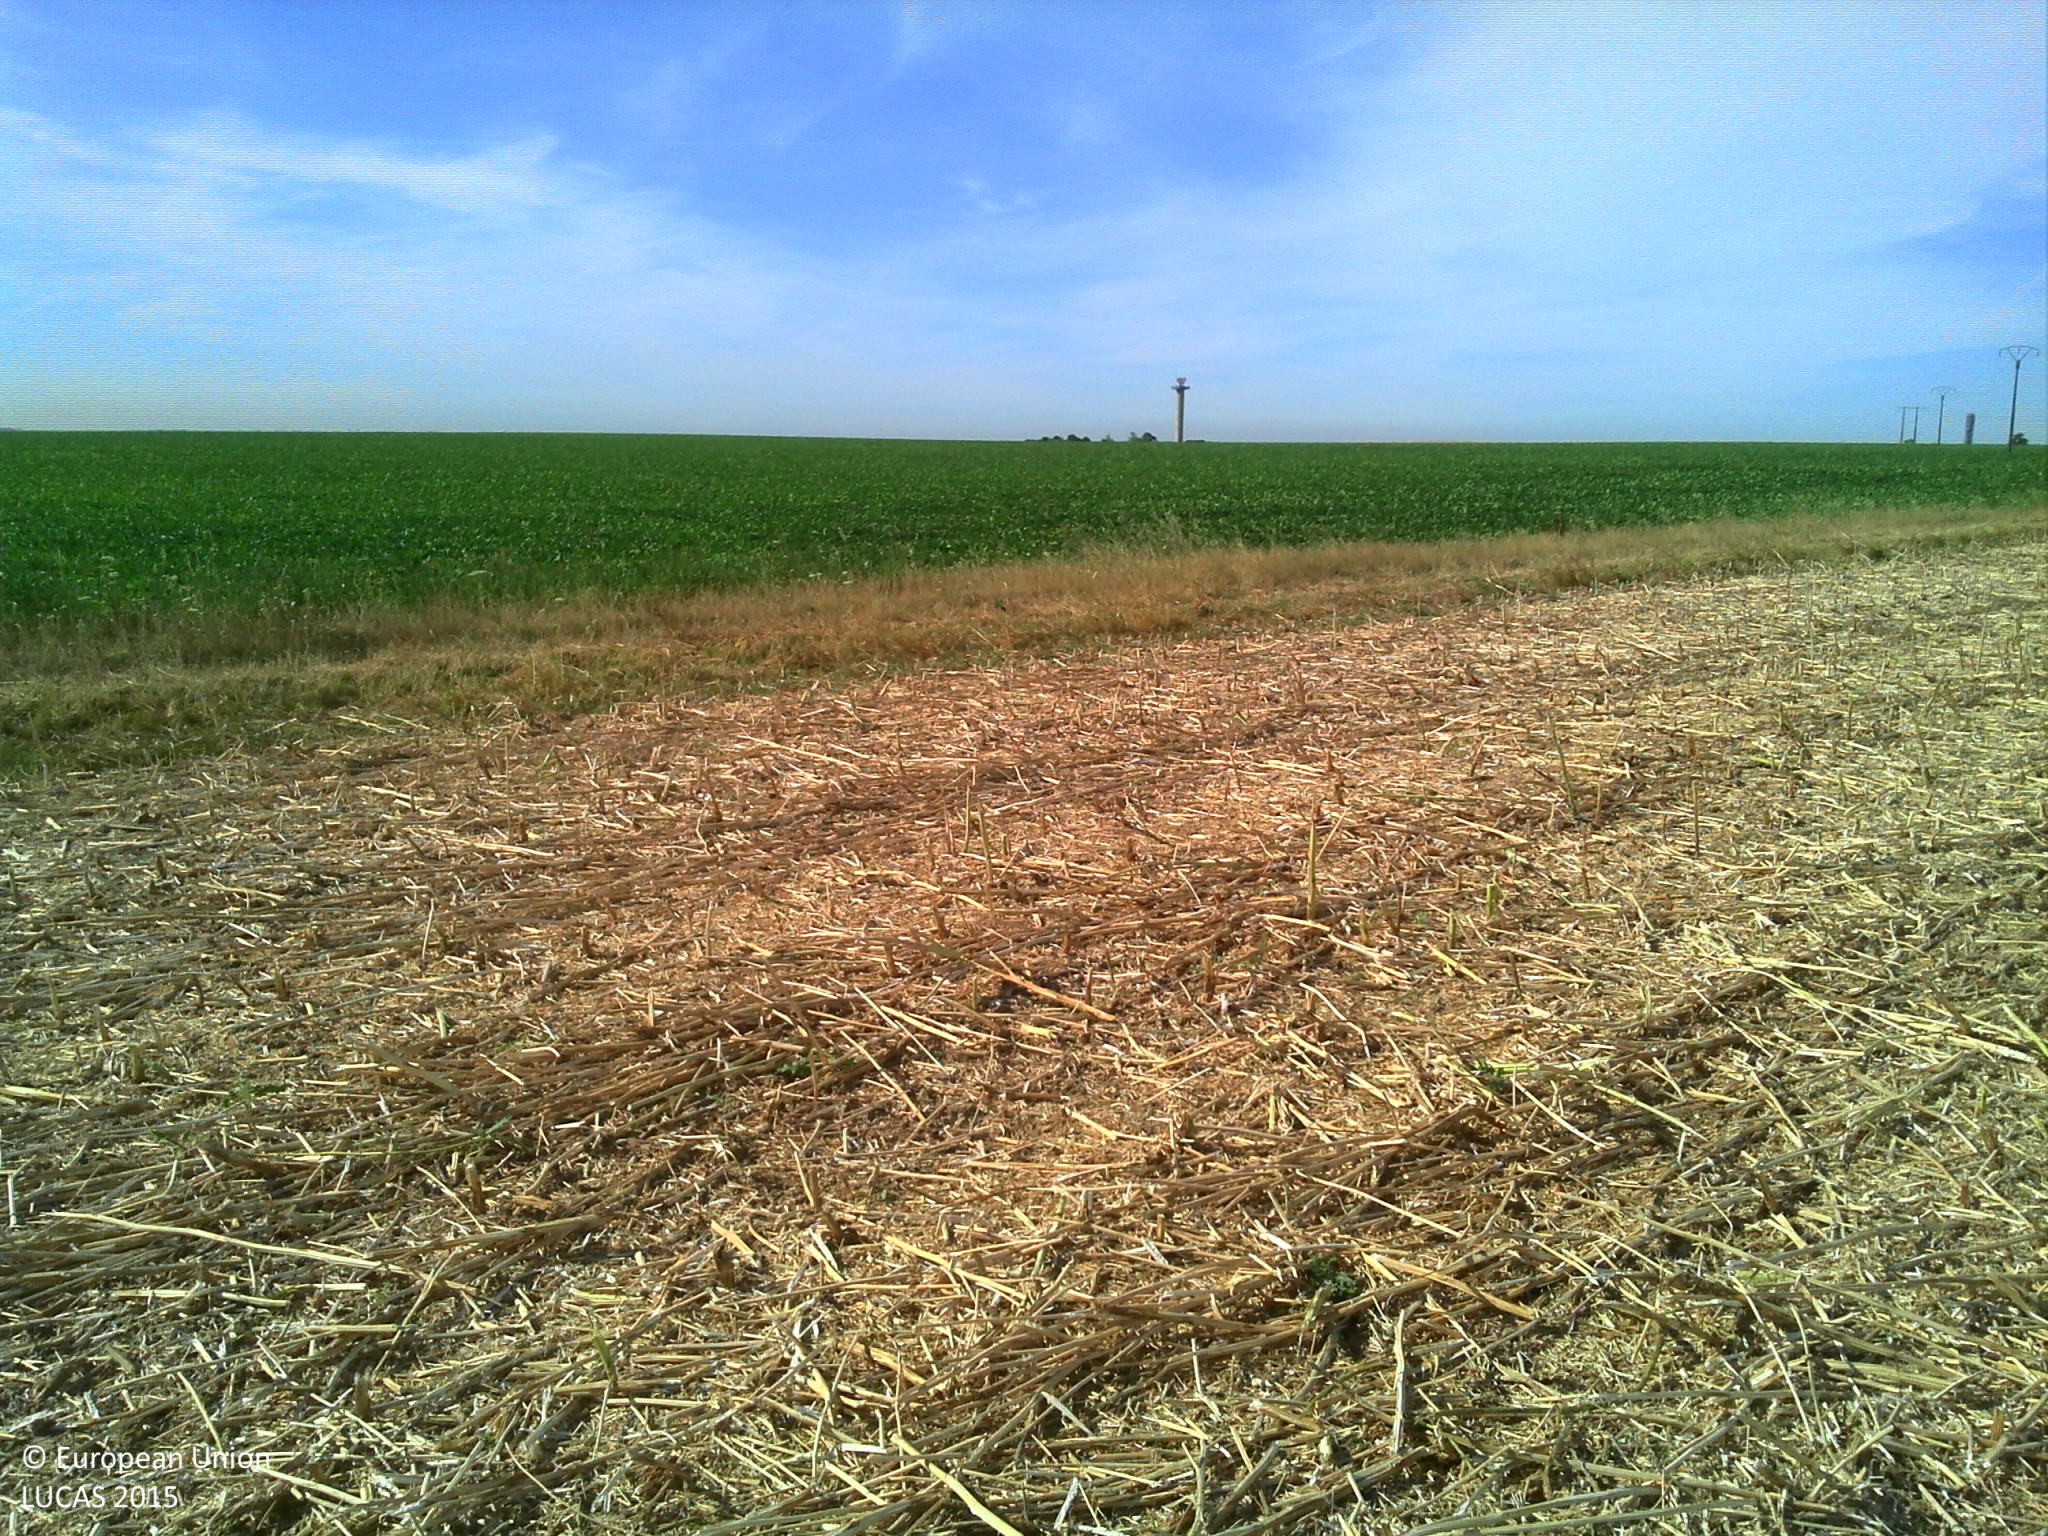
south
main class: Cropland
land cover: Rape and turnip rape
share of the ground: 10 - 25 %
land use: Agriculture (excluding fallow land and kitchen gardens)
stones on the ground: < 10 %
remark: Harvested field
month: August
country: FR
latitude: 49.0237
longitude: 2.6181
